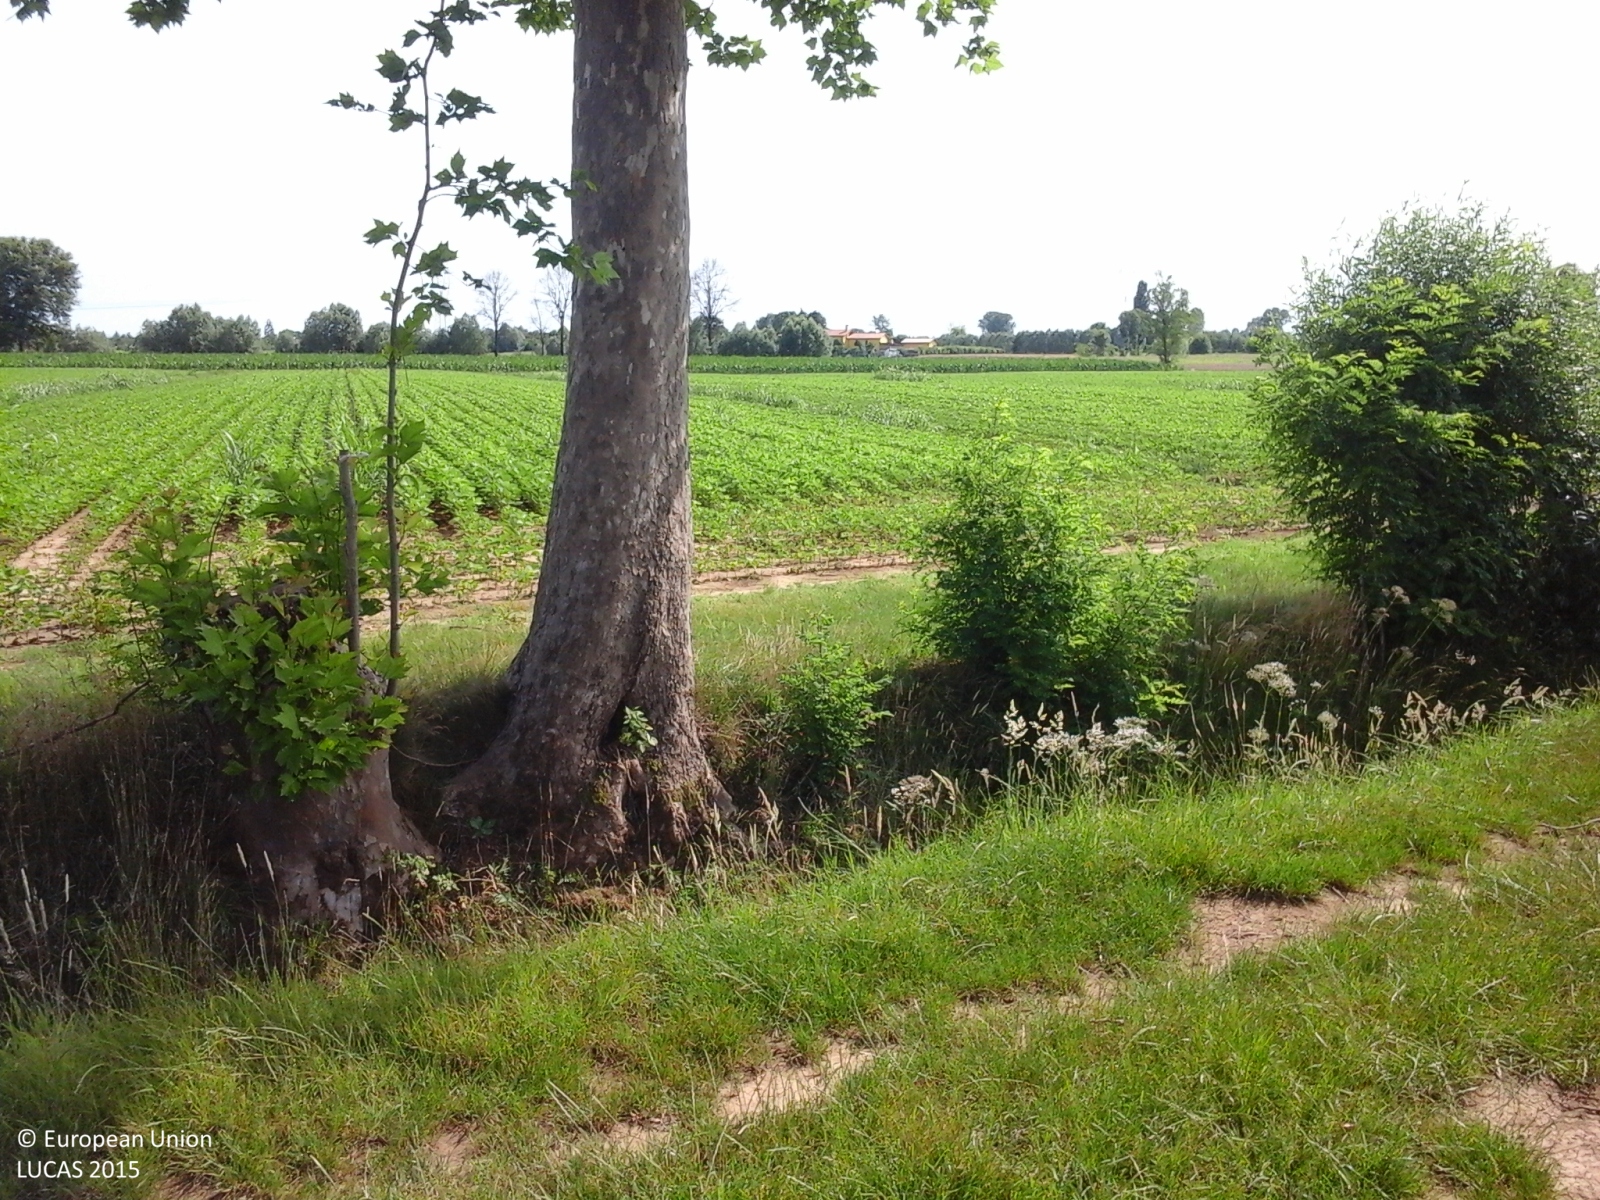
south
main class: Cropland
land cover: Other cereals
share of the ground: 50 - 75 %
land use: Agriculture (excluding fallow land and kitchen gardens)
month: June
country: IT
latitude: 45.7928
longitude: 12.7622
